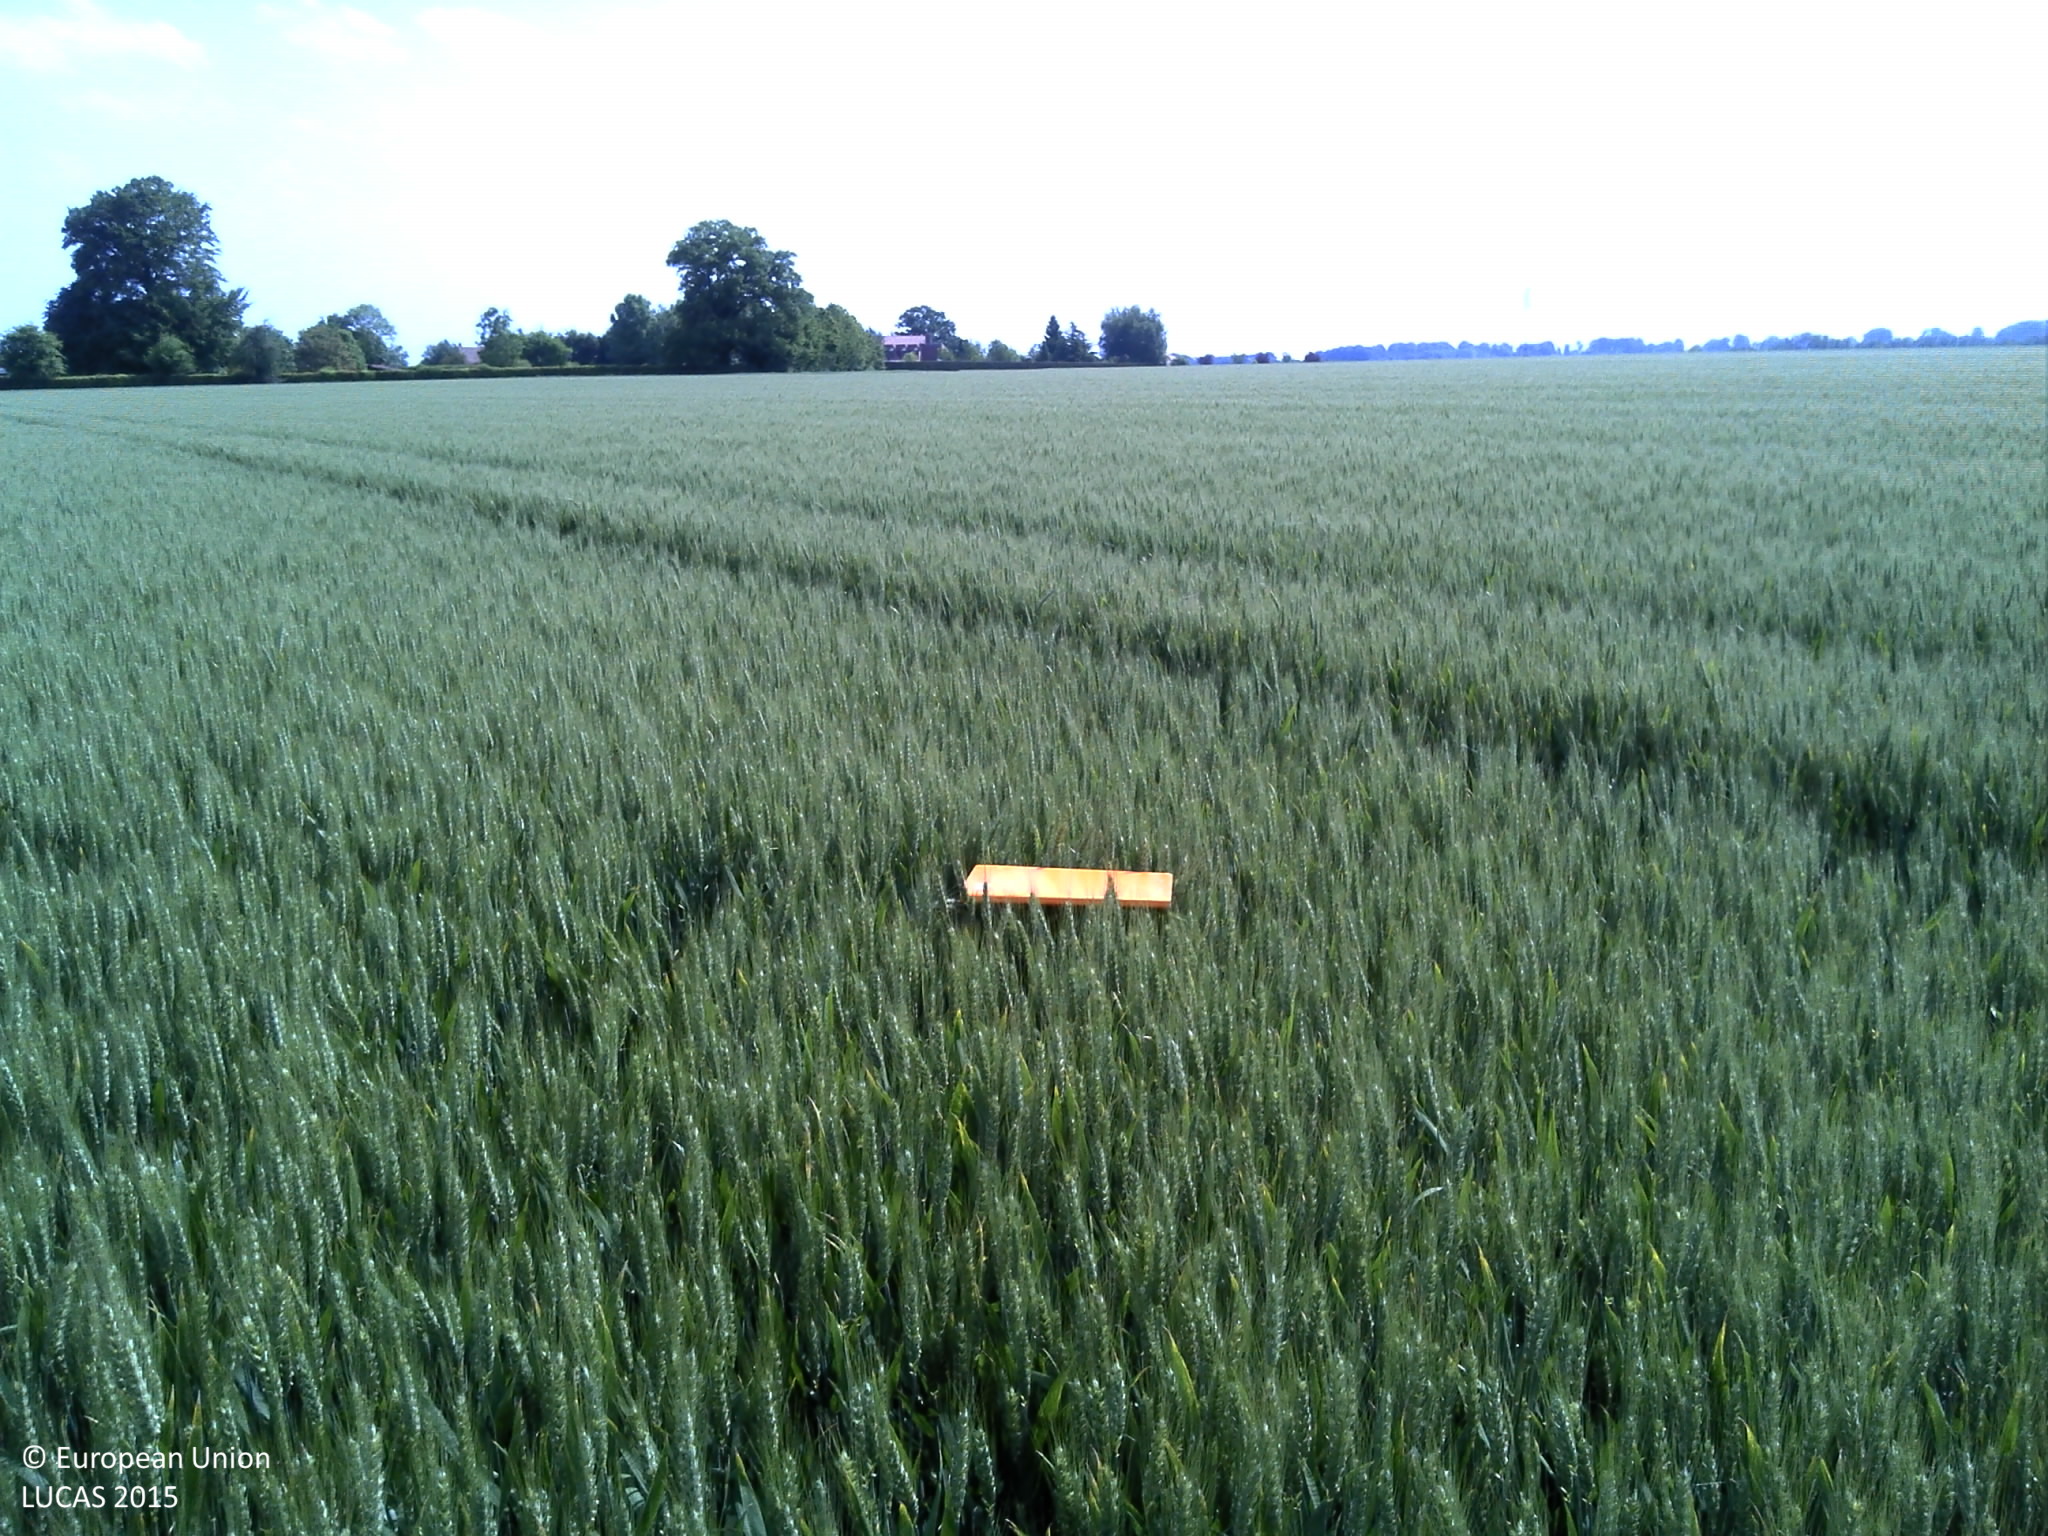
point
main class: Cropland
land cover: Common wheat
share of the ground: > 75 %
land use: Agriculture (excluding fallow land and kitchen gardens)
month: June
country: FR
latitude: 49.7595
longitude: 1.0519
